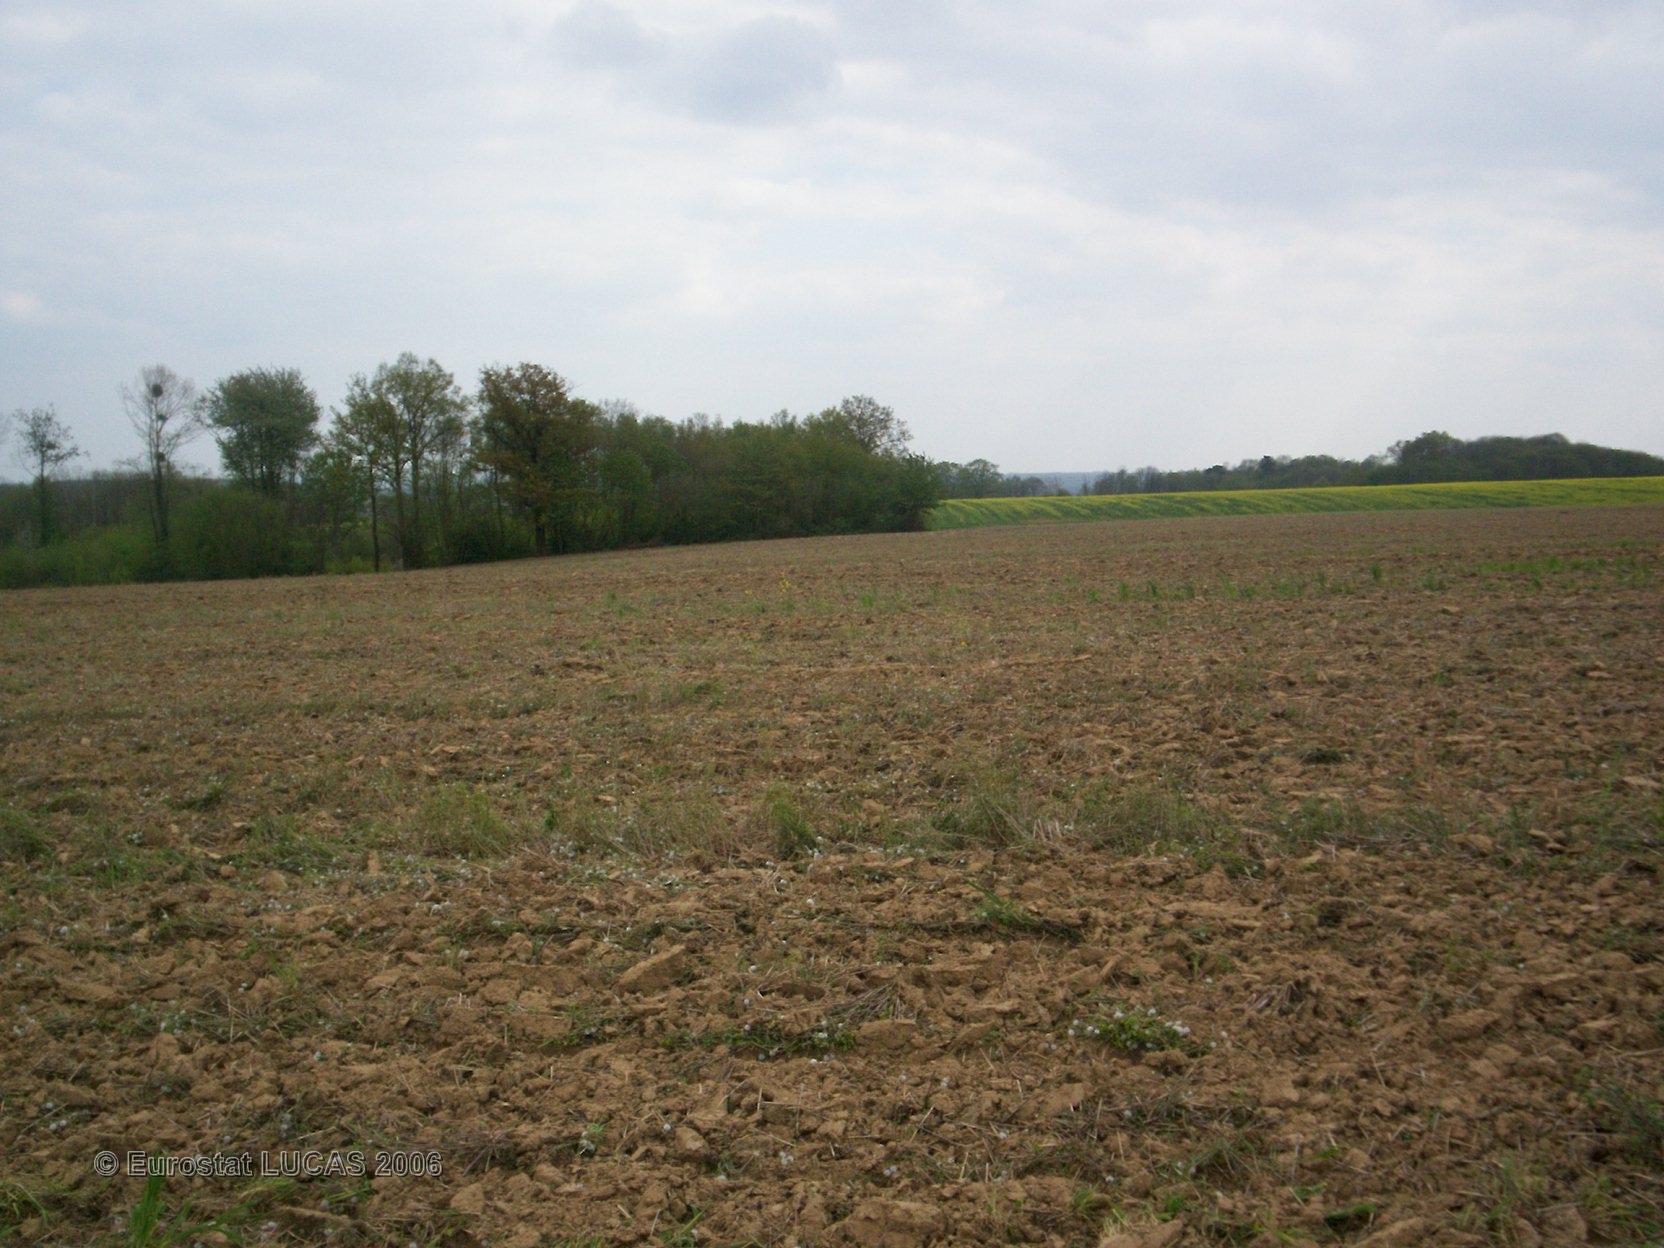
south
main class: Cropland
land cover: Maize
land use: Agriculture (excluding fallow land and kitchen gardens)
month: May
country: FR
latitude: 47.7221
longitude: 0.0955
